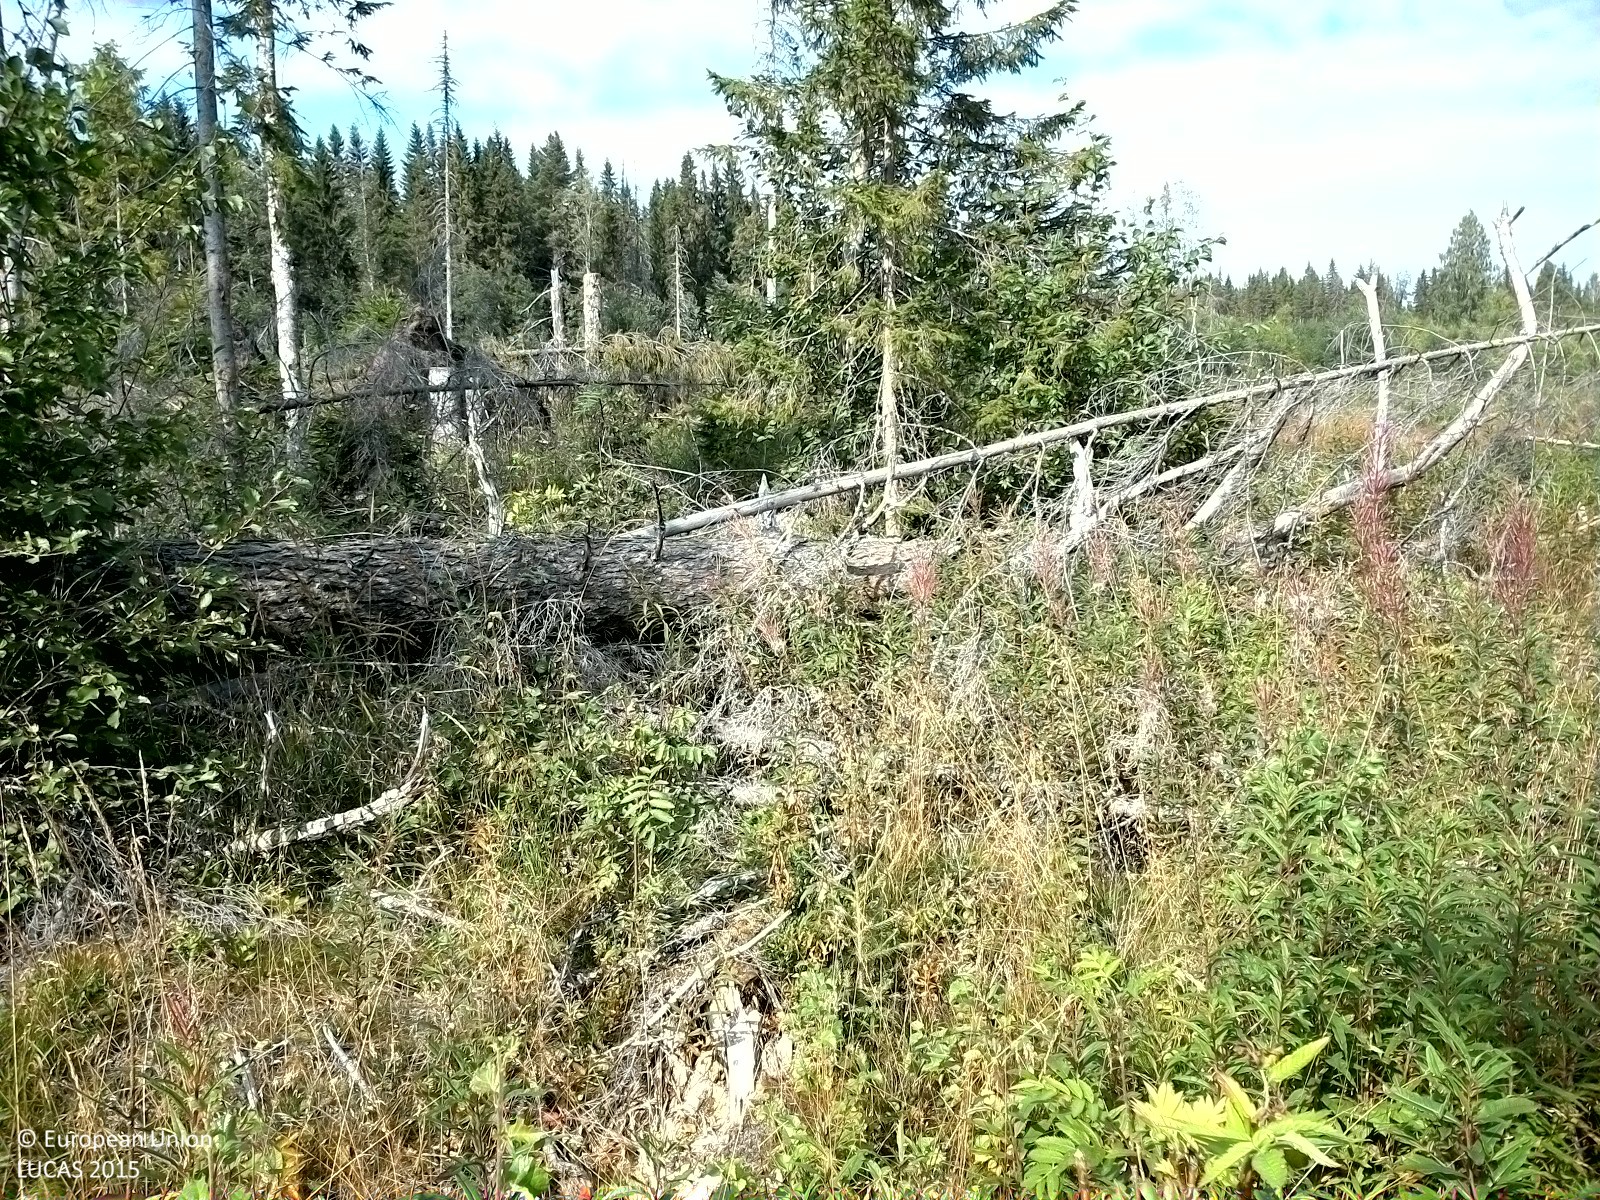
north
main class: Woodland
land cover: Spruce dominated mixed woodland
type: boreal forest
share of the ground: 25 - 50 %
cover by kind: herbaceous plants 55 %, broadleaved forest trees 20 %, coniferous forest trees 10 %, shrubs 5 %
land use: Forestry
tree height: > 5 m
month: August
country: SE
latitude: 62.4126
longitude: 16.1929
